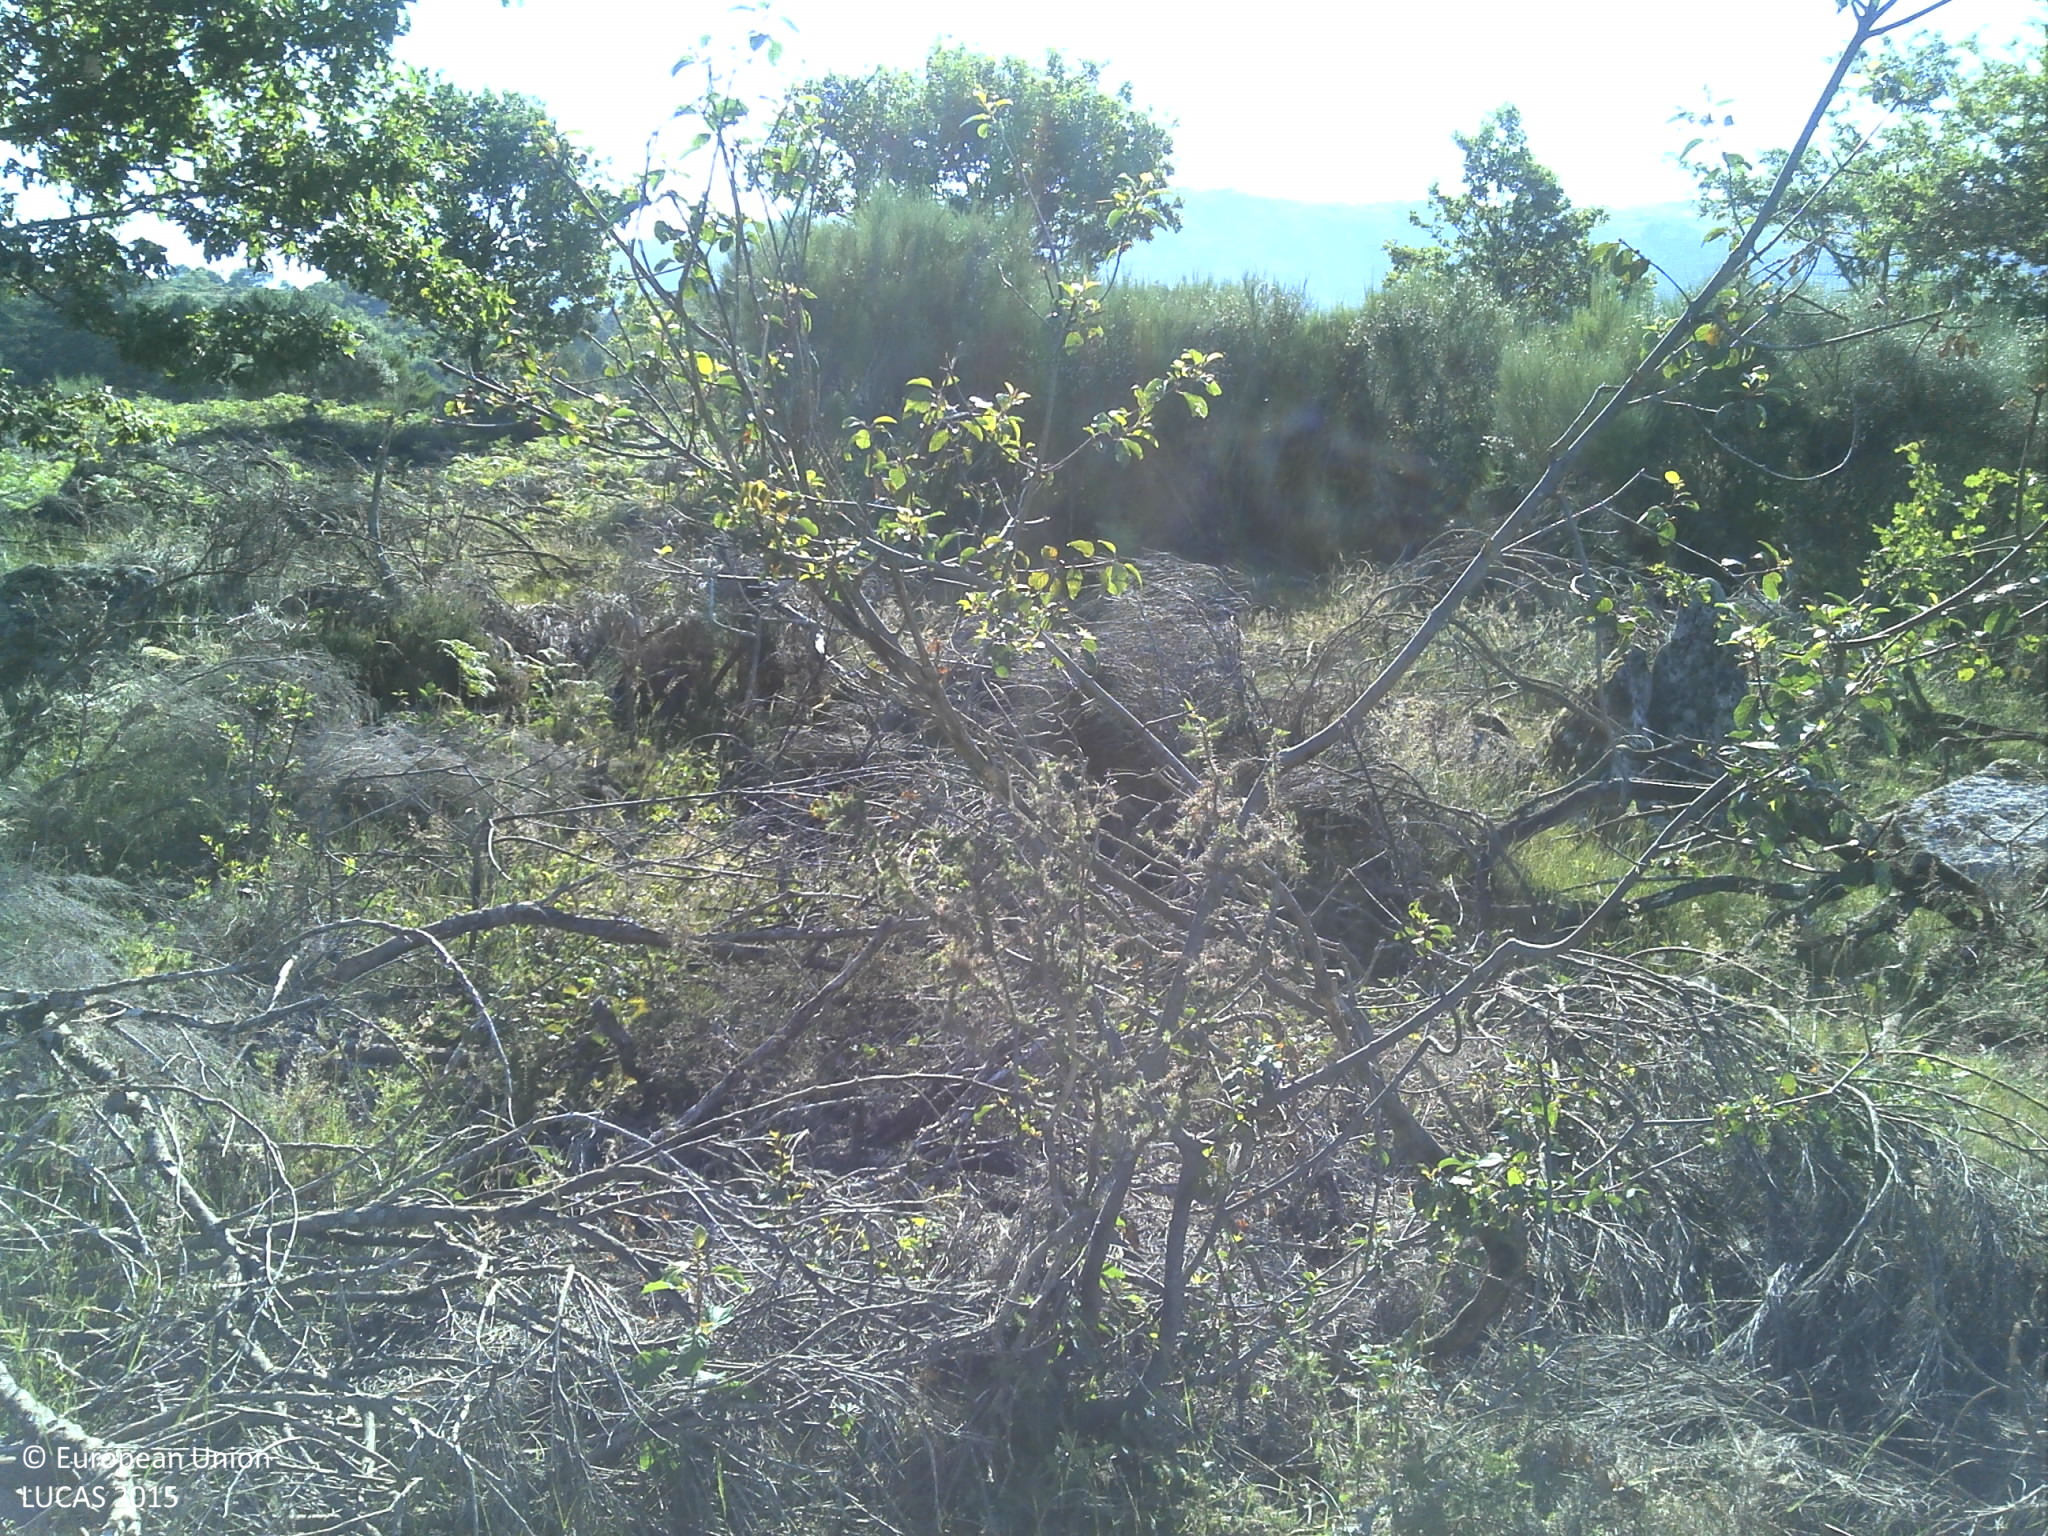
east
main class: Shrubland
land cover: Shrubland with sparse tree cover
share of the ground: > 75 %
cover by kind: shrubs 80 %, herbaceous plants 10 %, broadleaved forest trees 5 %, unconsolidated bare surface 5 %
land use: Agriculture (excluding fallow land and kitchen gardens)
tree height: < 5 m
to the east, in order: Shrubland with sparse tree cover; Dry stone walls; Shrubland without tree cover; Single bushes/trees; Dry stone walls; Shrubland without tree cover; Tracks; Abandoned hedges; Grassland without tree/shrub cover; Rivers and streams; Grassland without tree/shrub cover; Dry stone walls; Grassland without tree/shrub cover; Dry stone walls; Grass margins; Tracks; Shrubland without tree cover; Dry stone walls; Shrubland without tree cover
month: July
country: PT
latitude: 41.4254
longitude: -7.8323
